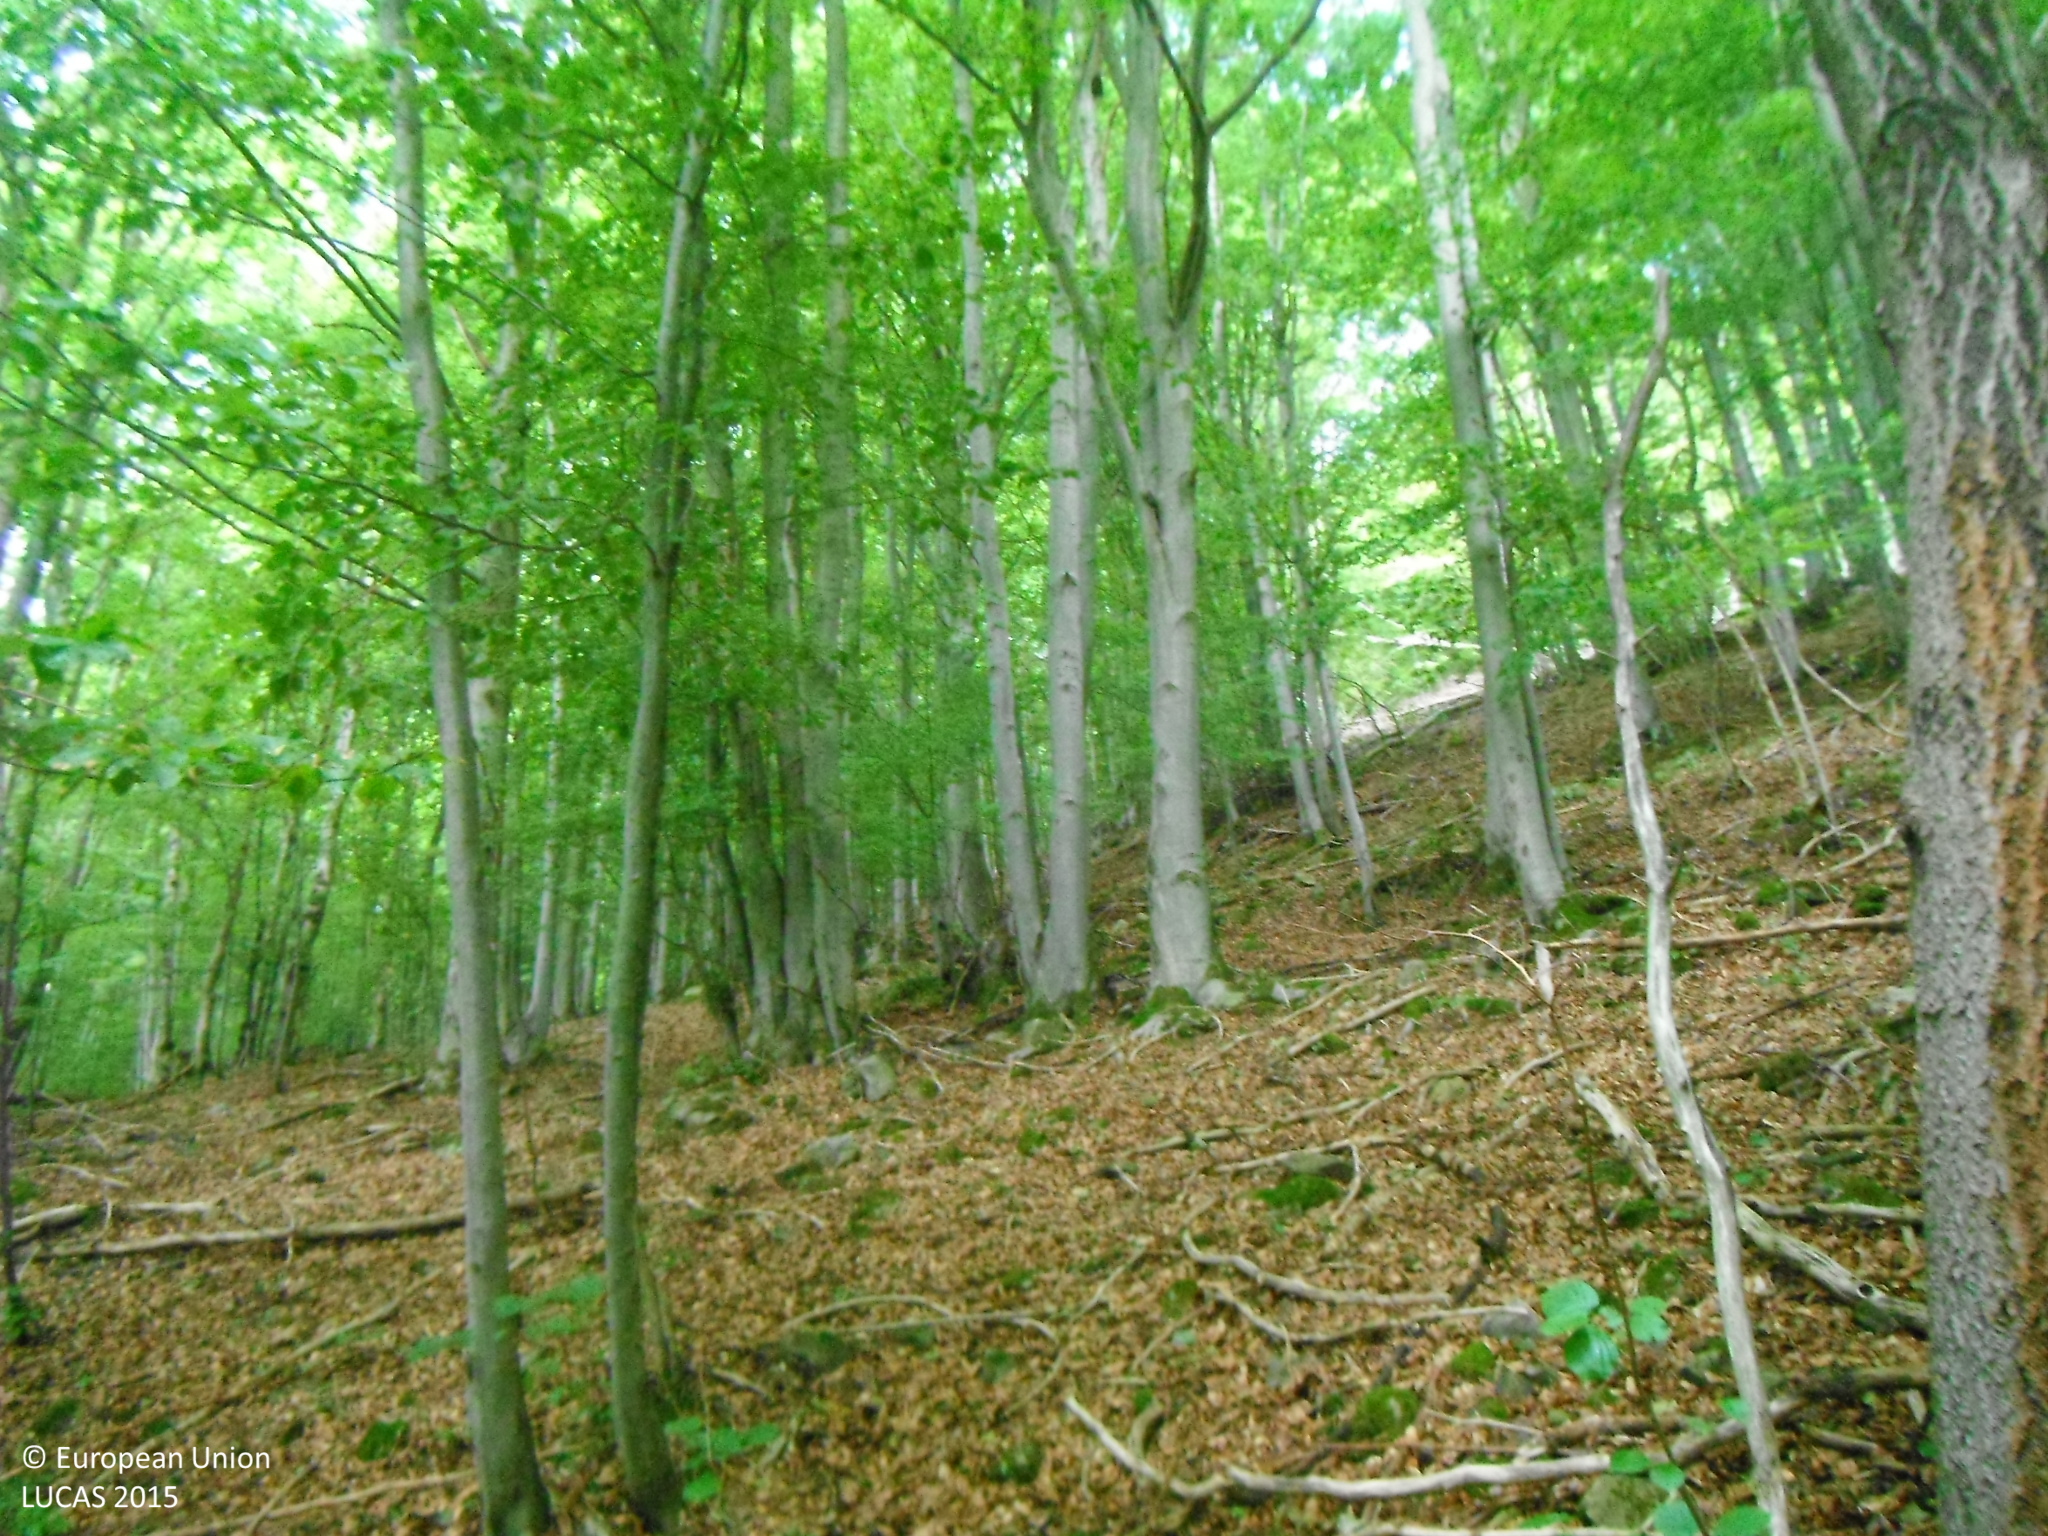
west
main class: Woodland
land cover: Broadleaved woodland
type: mountainous beech forest
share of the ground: > 75 %
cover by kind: broadleaved forest trees 95 %, unconsolidated bare surface 5 %
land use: Forestry
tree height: > 5 m
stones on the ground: > 50 %
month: July
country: SK
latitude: 49.2663
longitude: 18.3035
